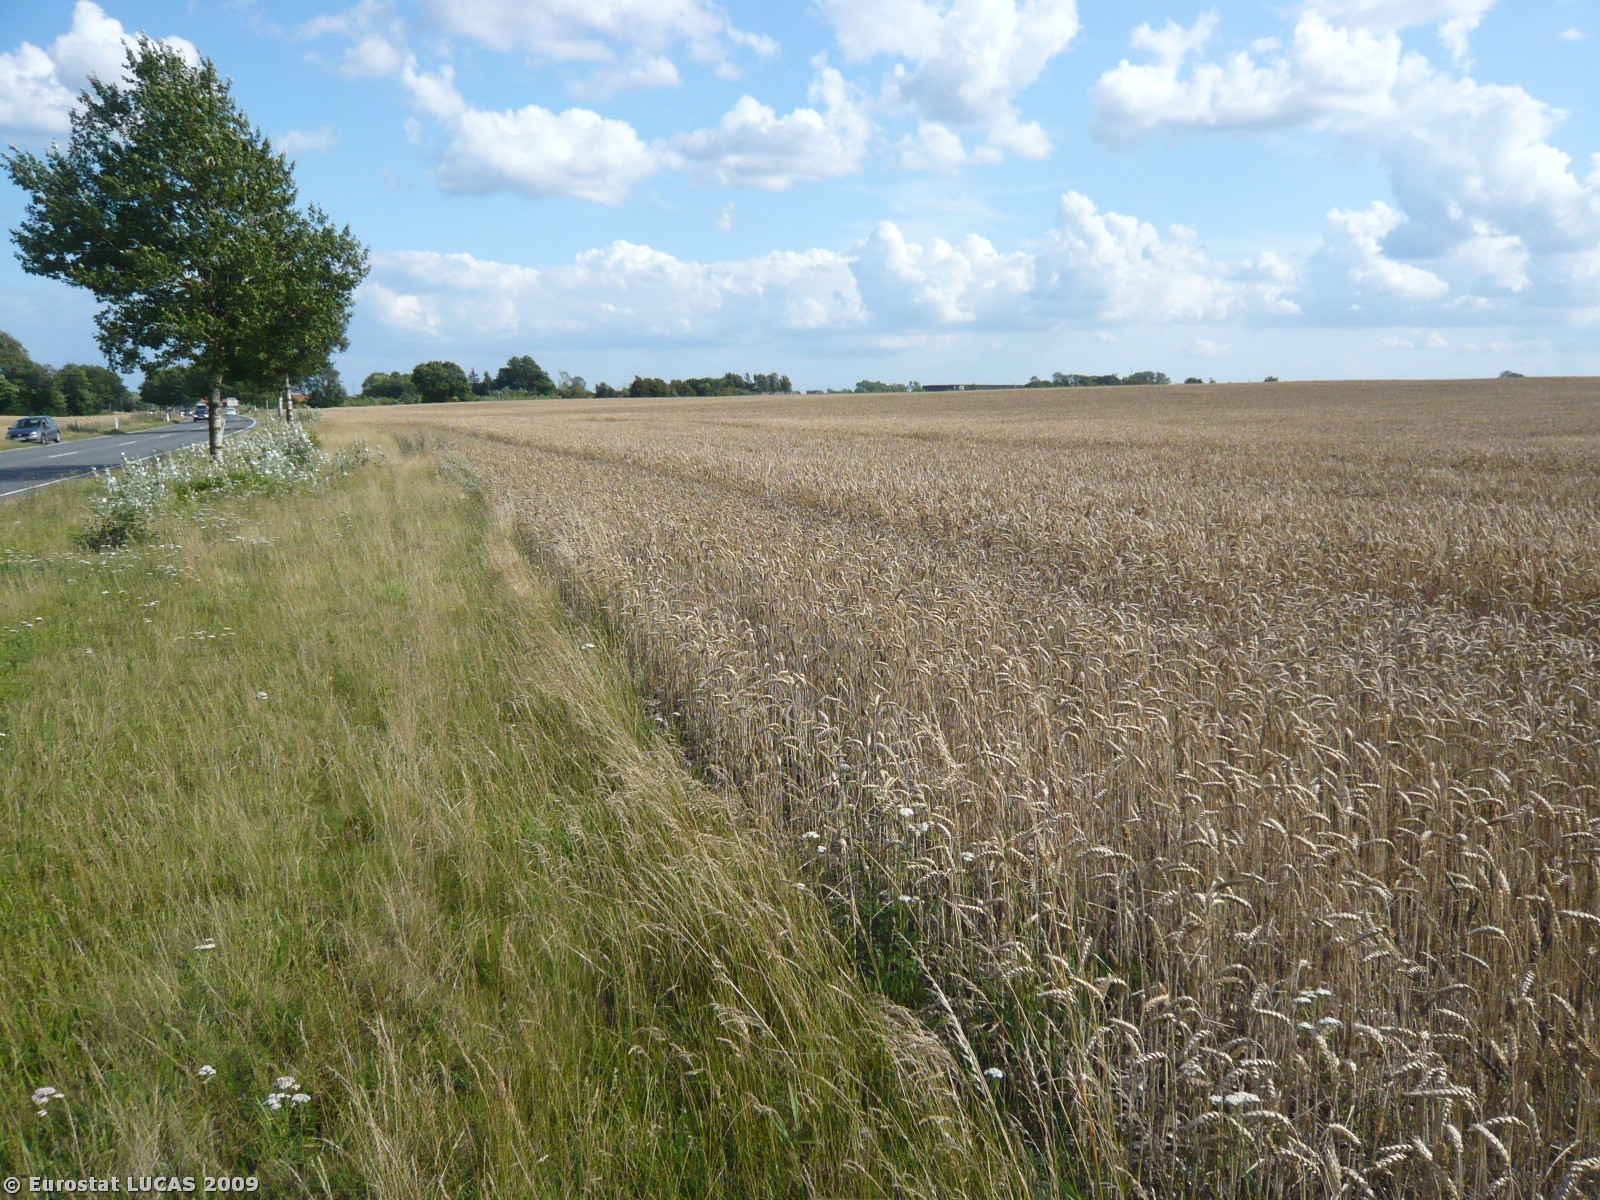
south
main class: Cropland
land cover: Common wheat
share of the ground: > 75 %
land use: Agriculture (excluding fallow land and kitchen gardens)
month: July
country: DK
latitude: 55.5929
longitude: 12.2356
